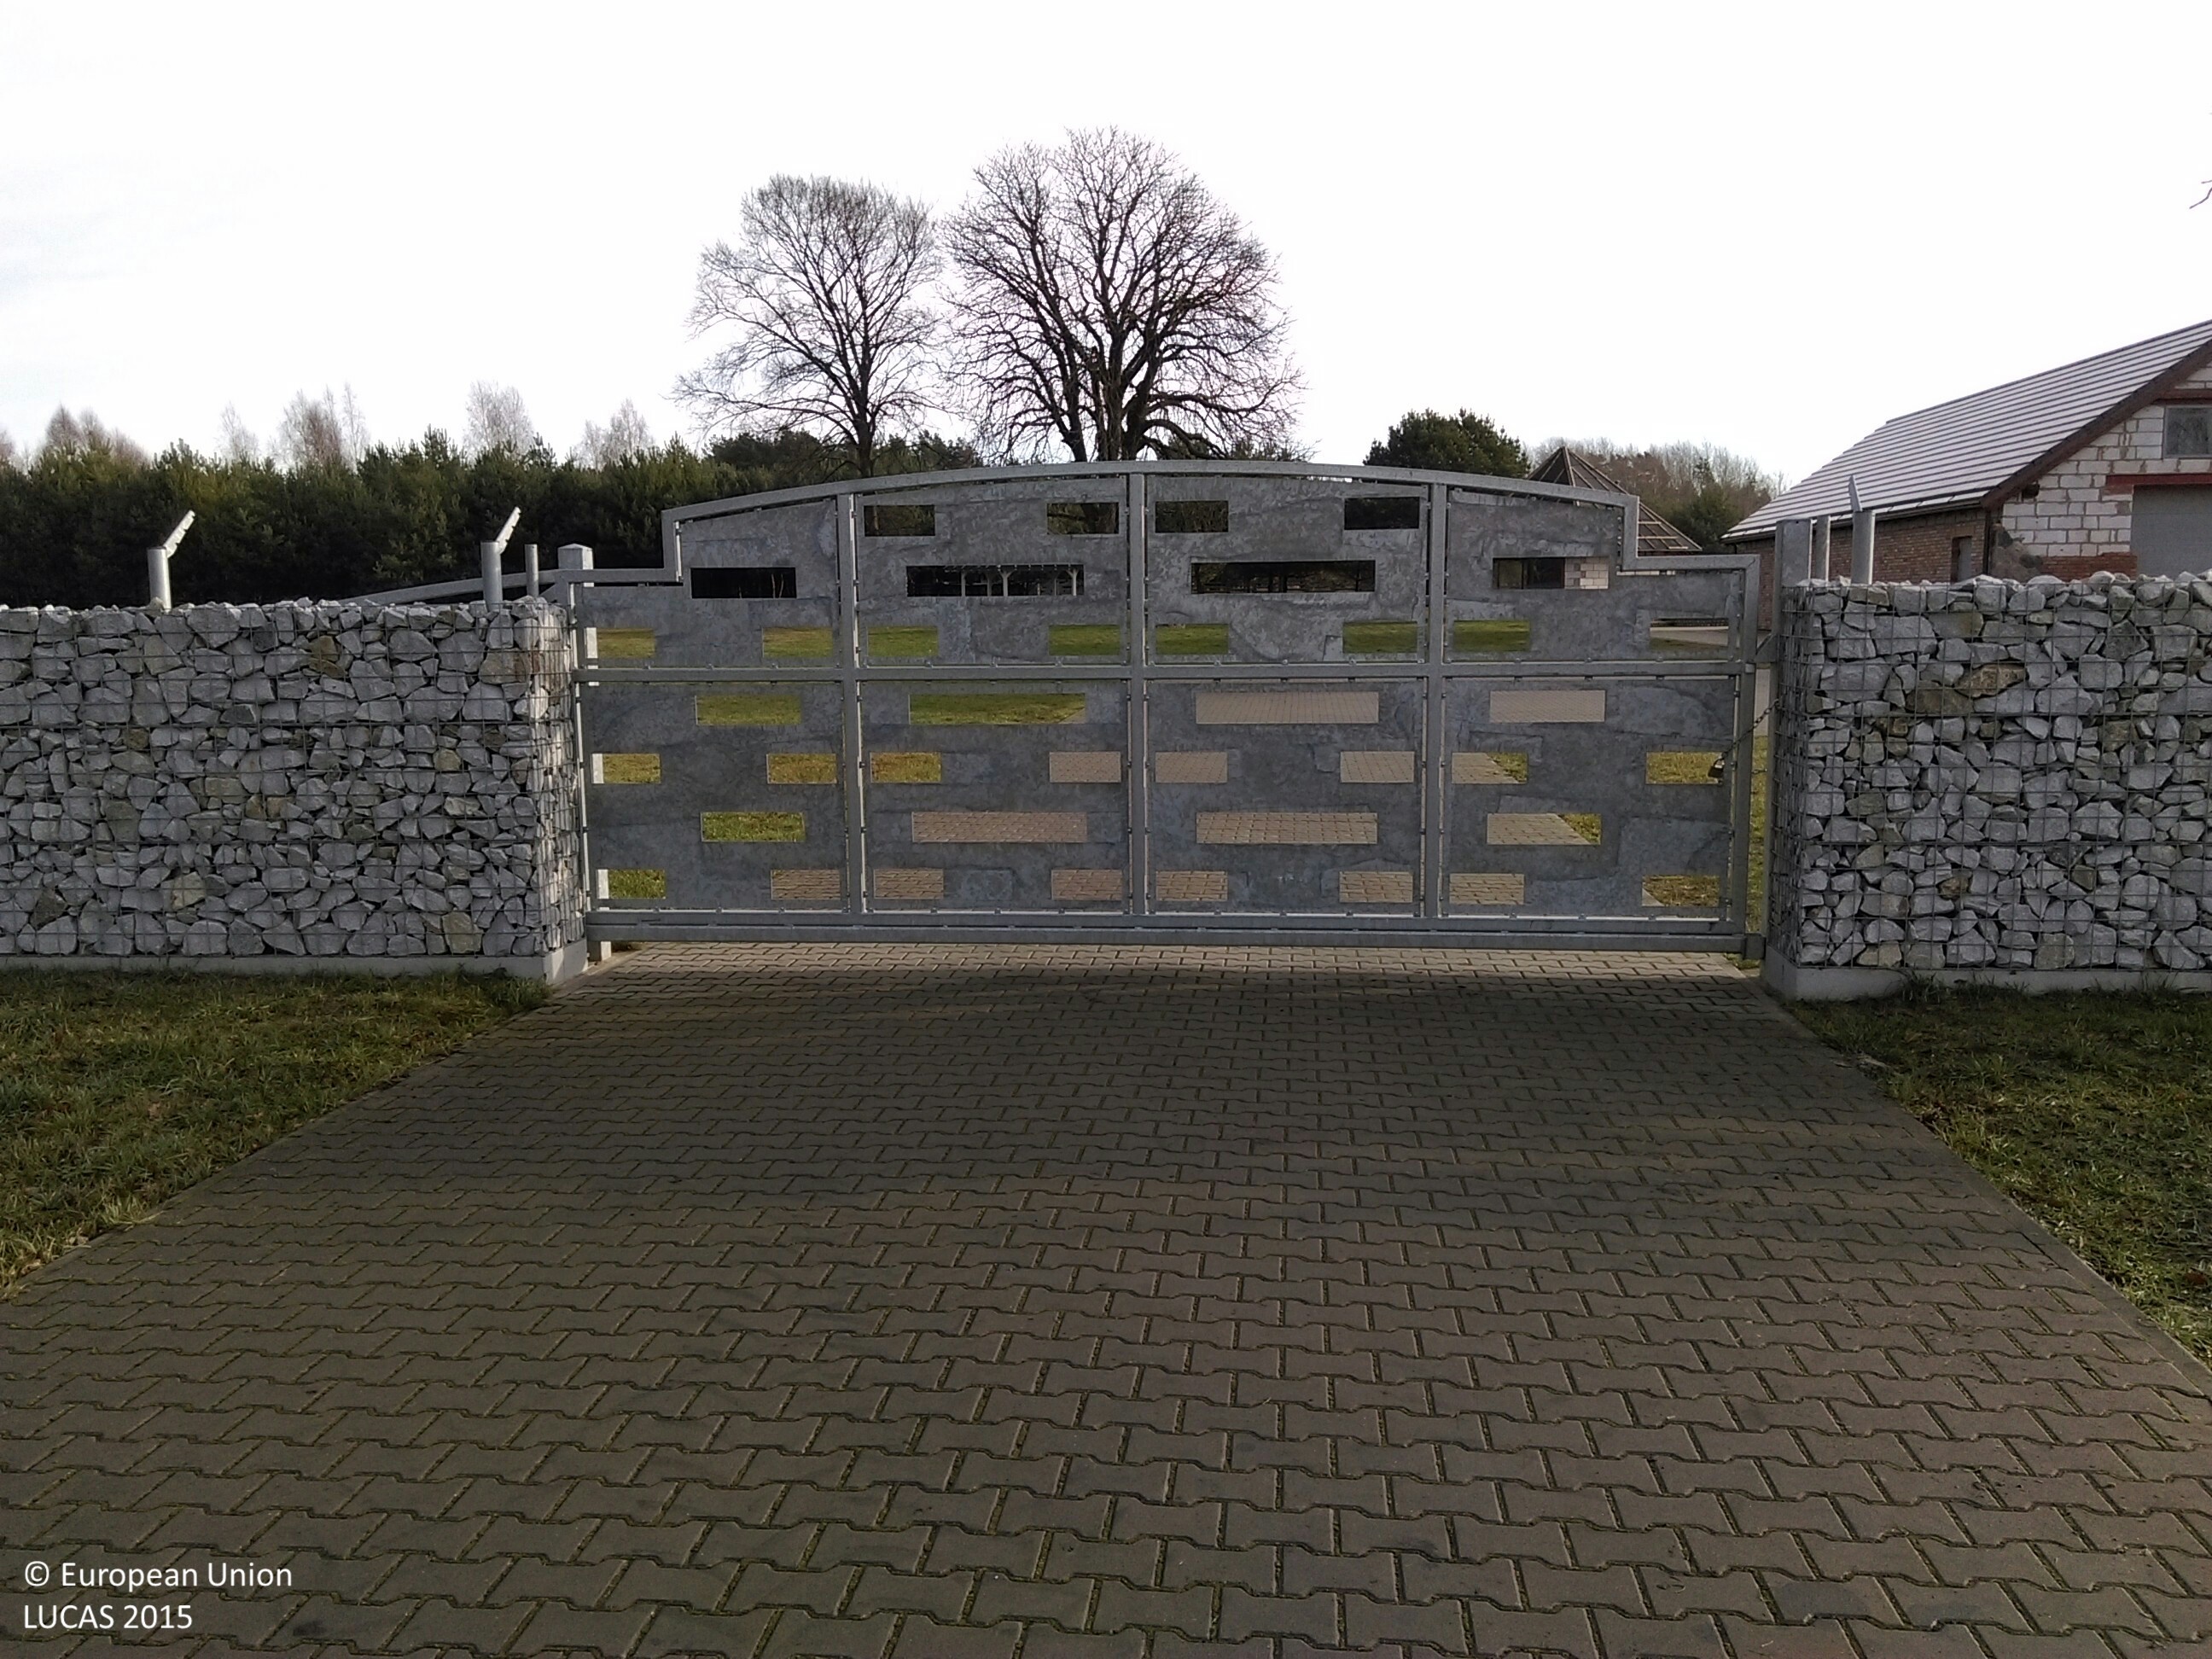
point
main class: Grassland
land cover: Grassland without tree/shrub cover
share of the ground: > 75 %
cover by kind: herbaceous plants 100 %
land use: Residential
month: December
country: PL
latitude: 52.2872
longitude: 16.2076
